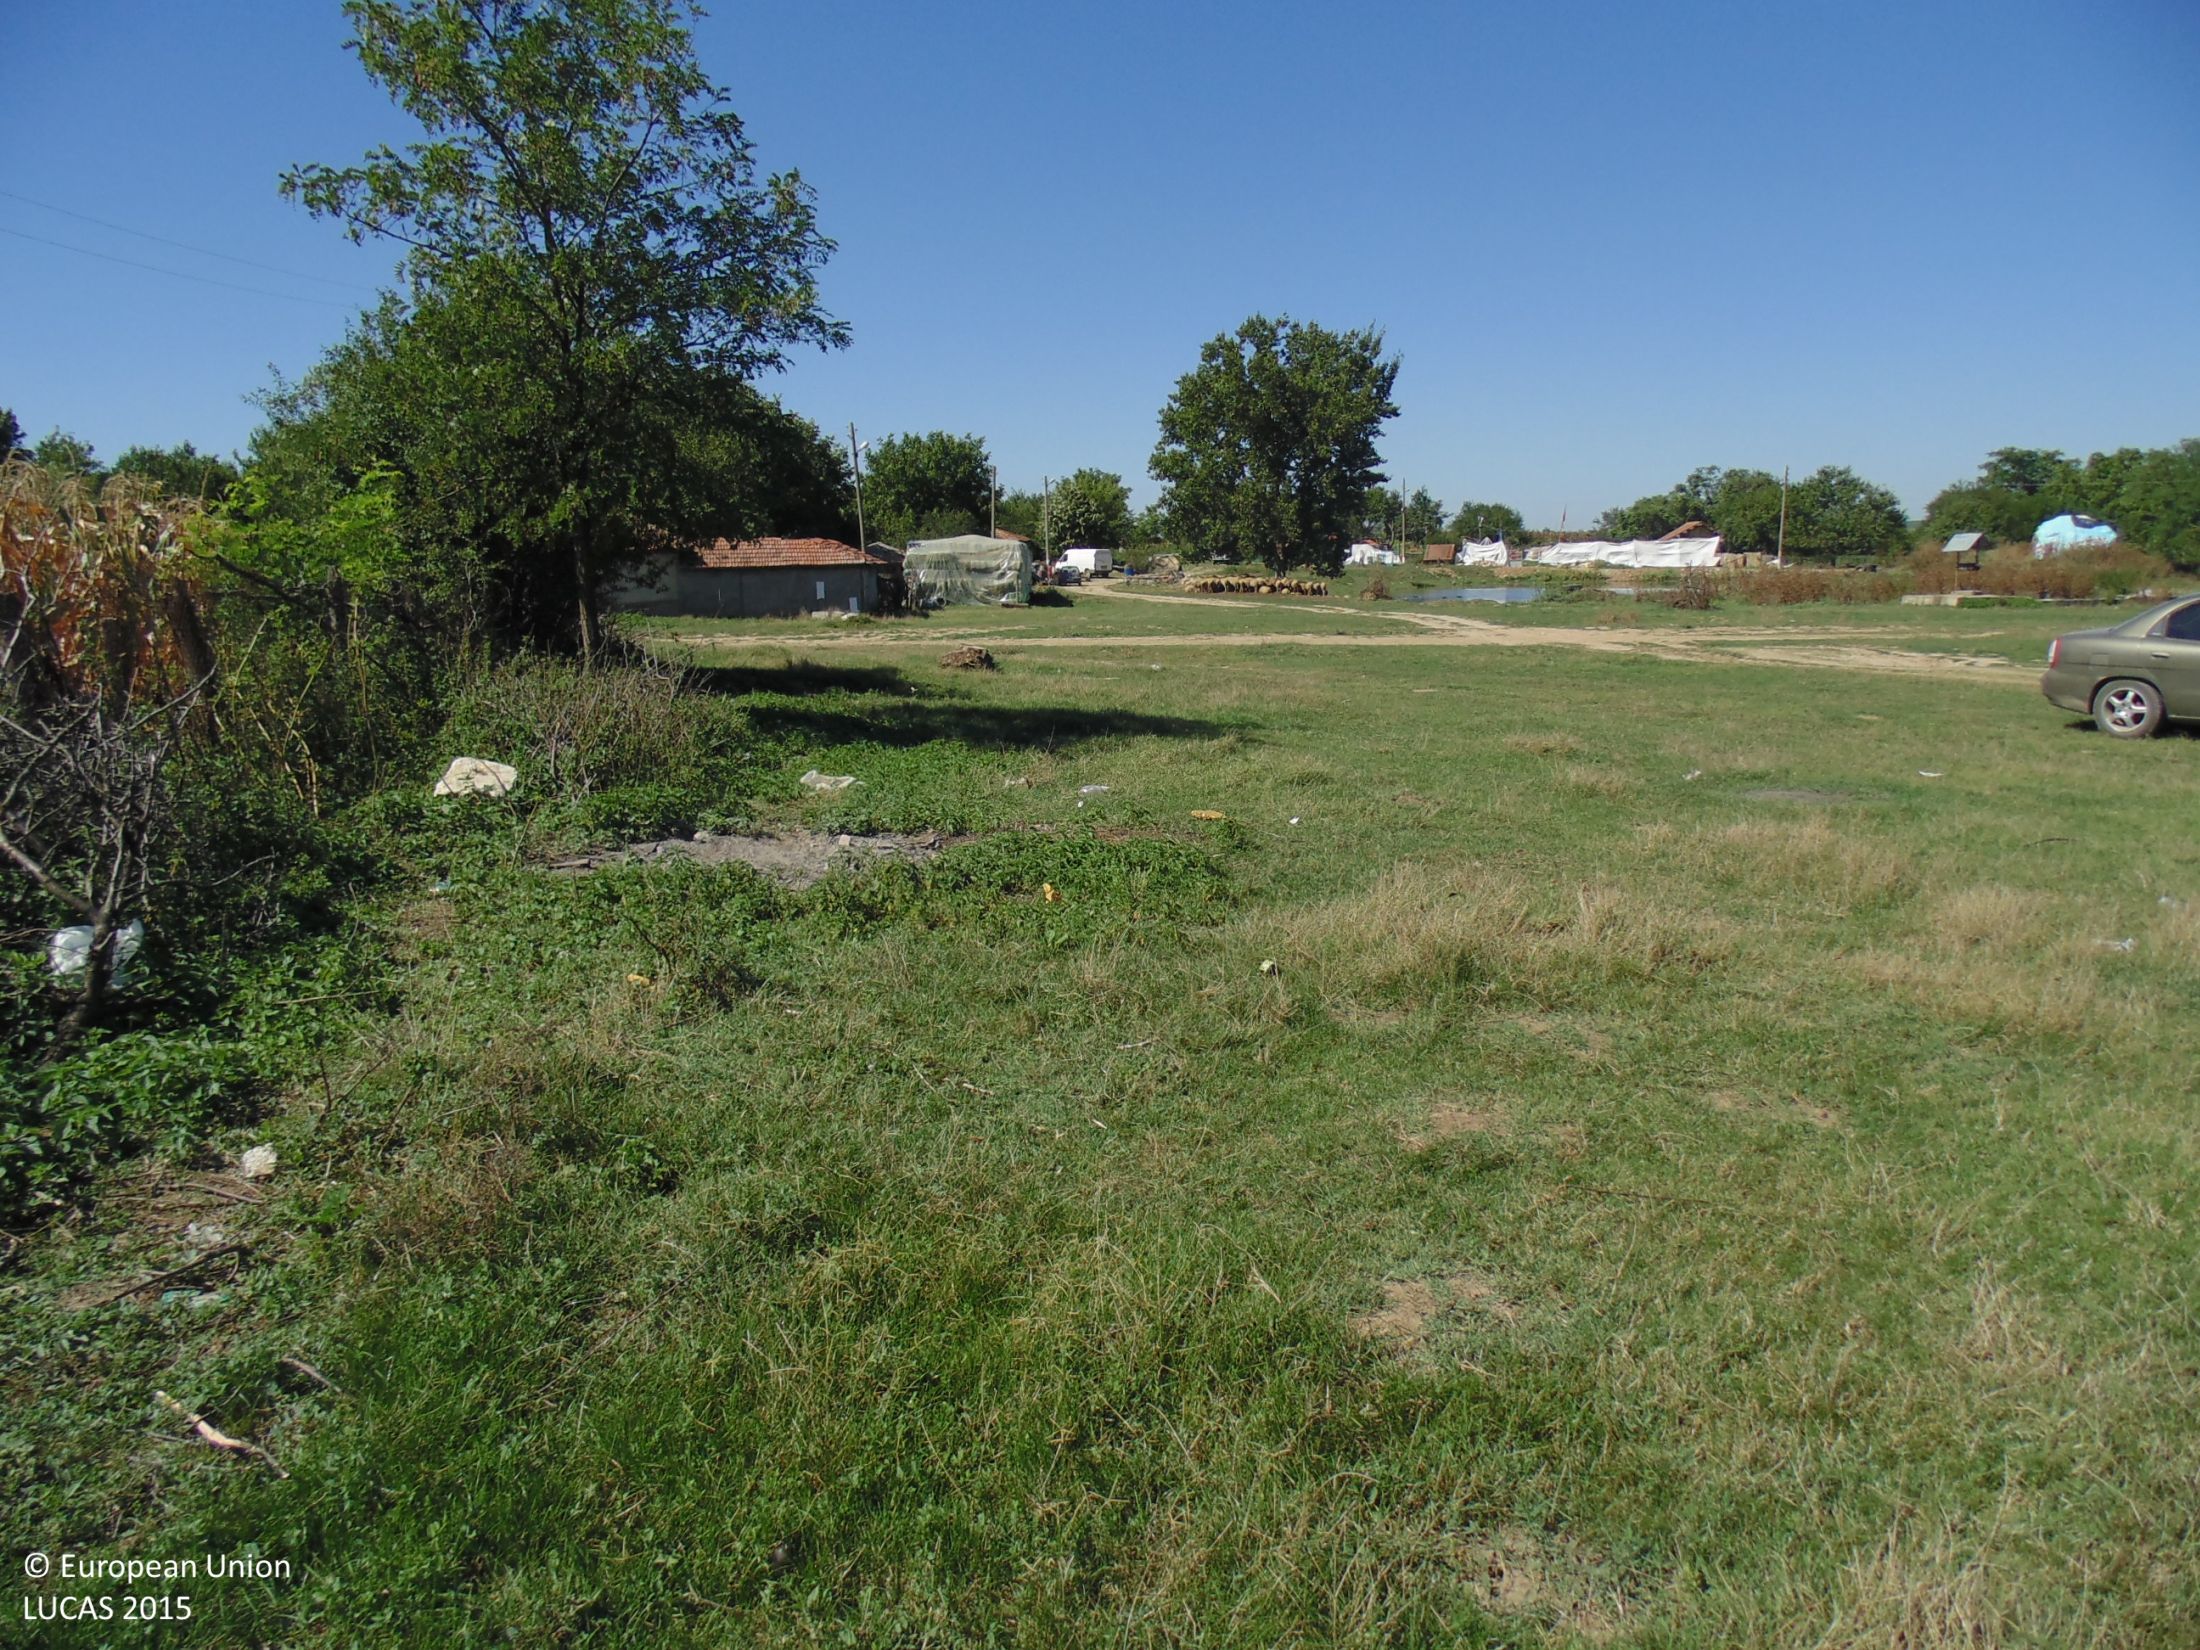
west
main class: Grassland
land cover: Grassland with sparse tree/shrub cover
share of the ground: > 75 %
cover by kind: herbaceous plants 90 %, broadleaved forest trees 5 %, shrubs 5 %
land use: Residential
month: September
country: BG
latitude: 43.8168
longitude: 27.1199
